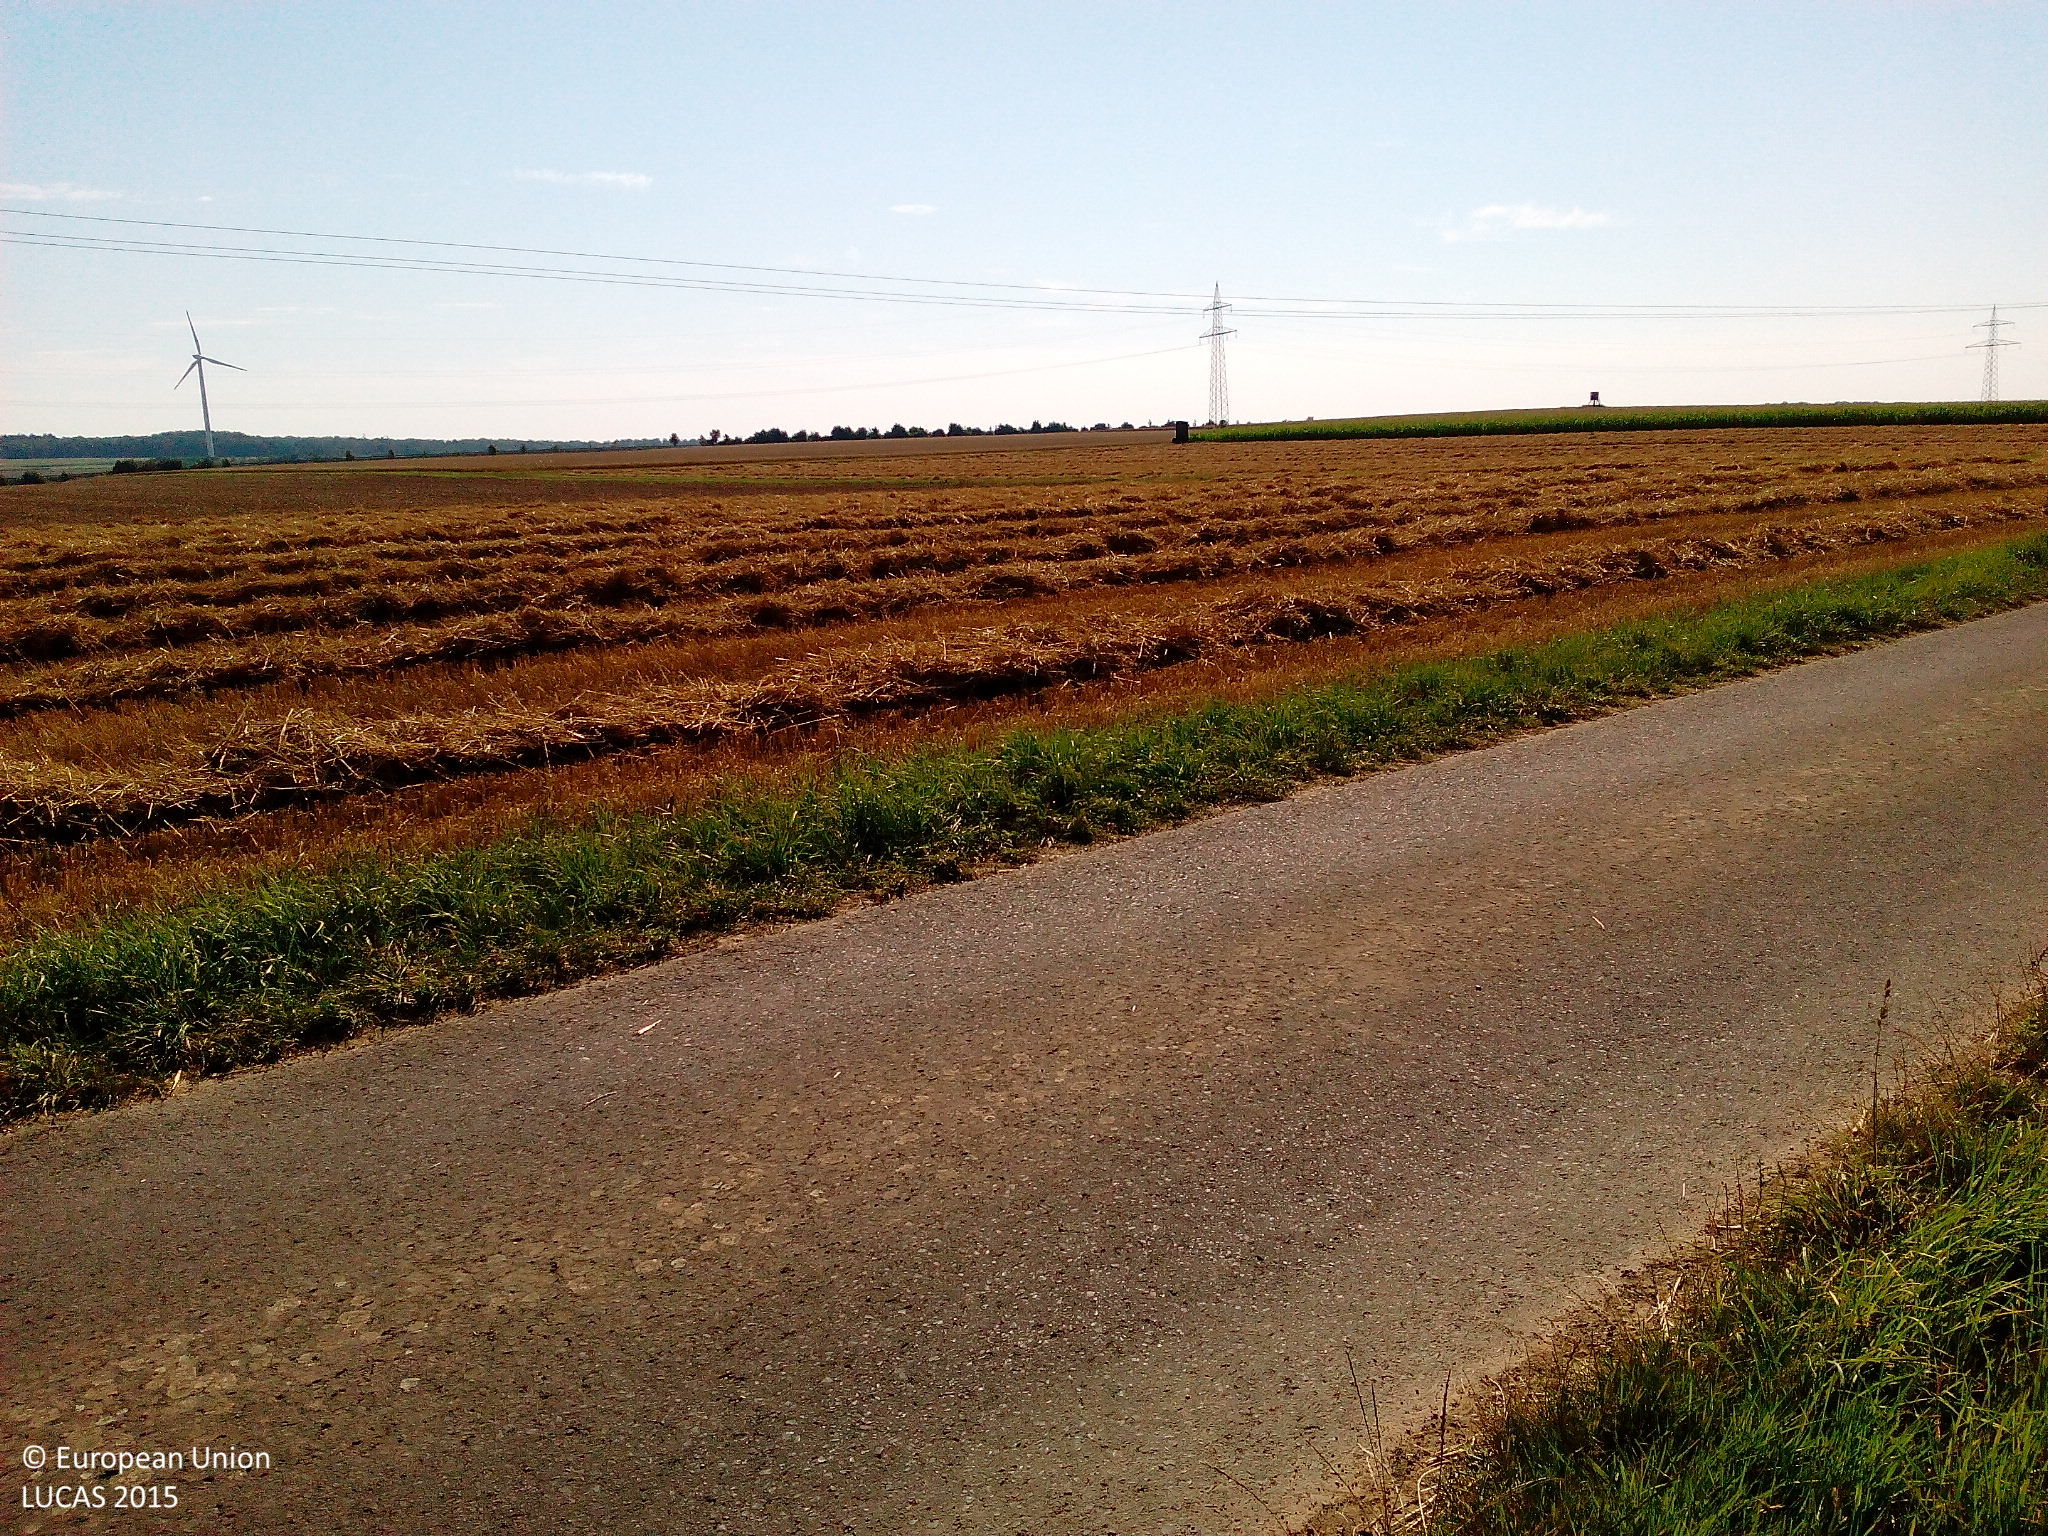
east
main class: Cropland
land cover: Maize
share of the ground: > 75 %
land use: Agriculture (excluding fallow land and kitchen gardens)
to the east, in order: Maize; Grass margins; Paved roads, cycling and walking lanes; Grass margins; Common wheat; Electric lines; Common wheat; Other bare soil; Grass margins; Tracks; Grass margins; Common wheat; Grass margins; Tracks; Grass margins; Common wheat
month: August
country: DE
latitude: 50.6858
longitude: 9.3350
